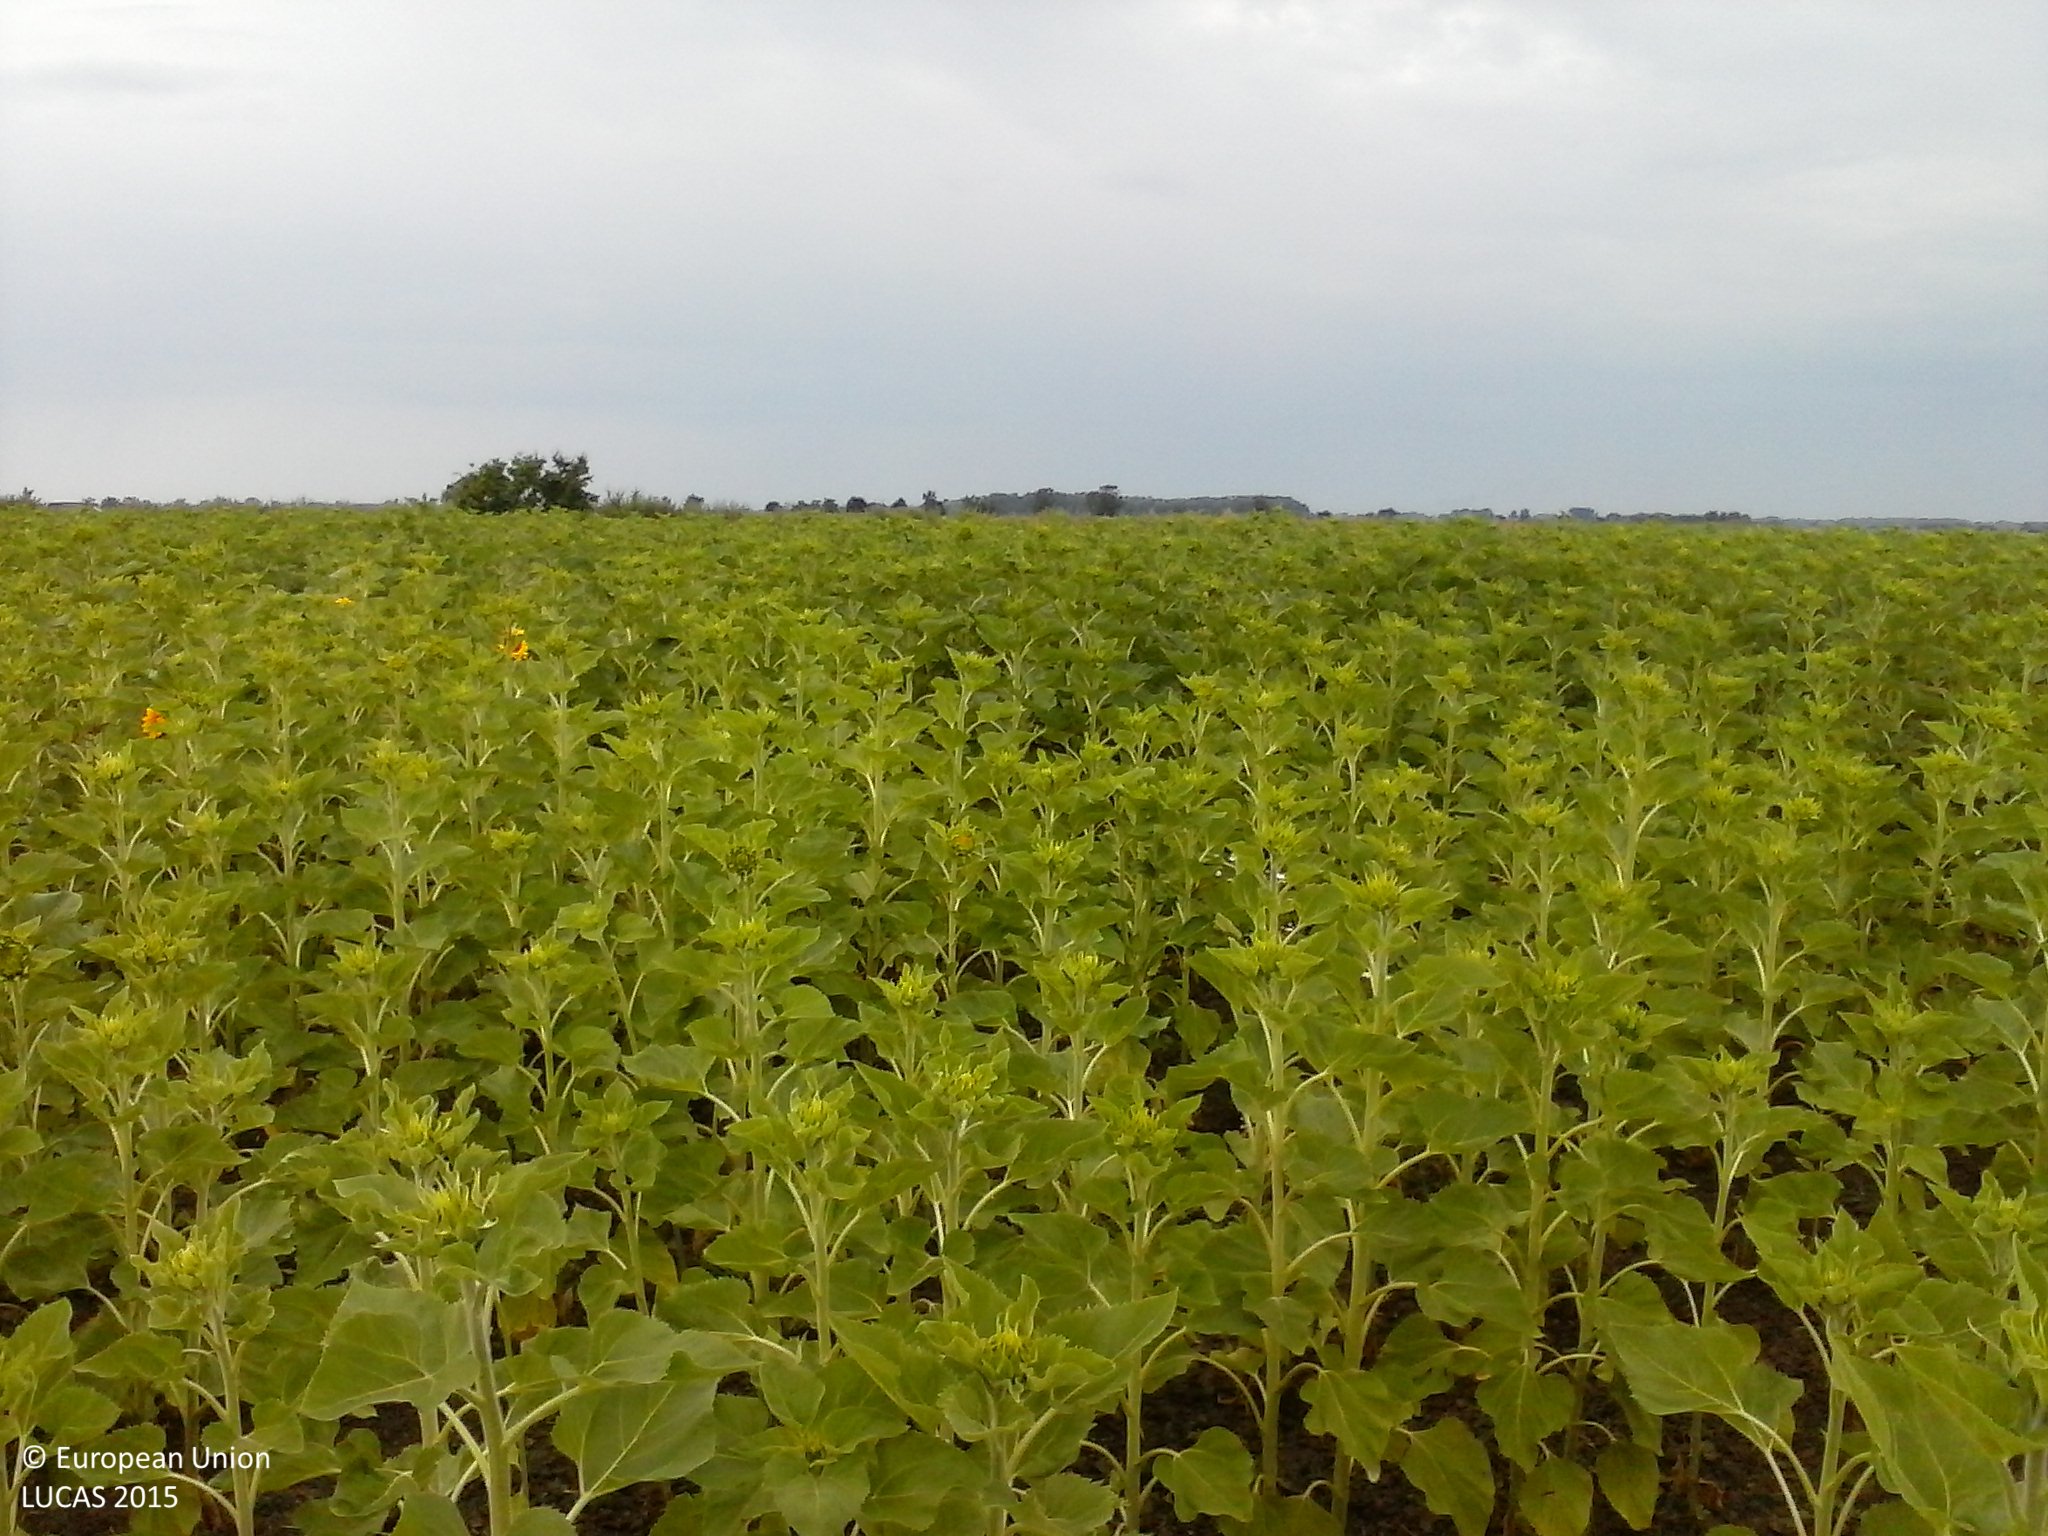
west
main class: Cropland
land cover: Sunflower
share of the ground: > 75 %
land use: Agriculture (excluding fallow land and kitchen gardens)
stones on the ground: < 10 %
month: June
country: HU
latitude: 46.2689
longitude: 20.3131
